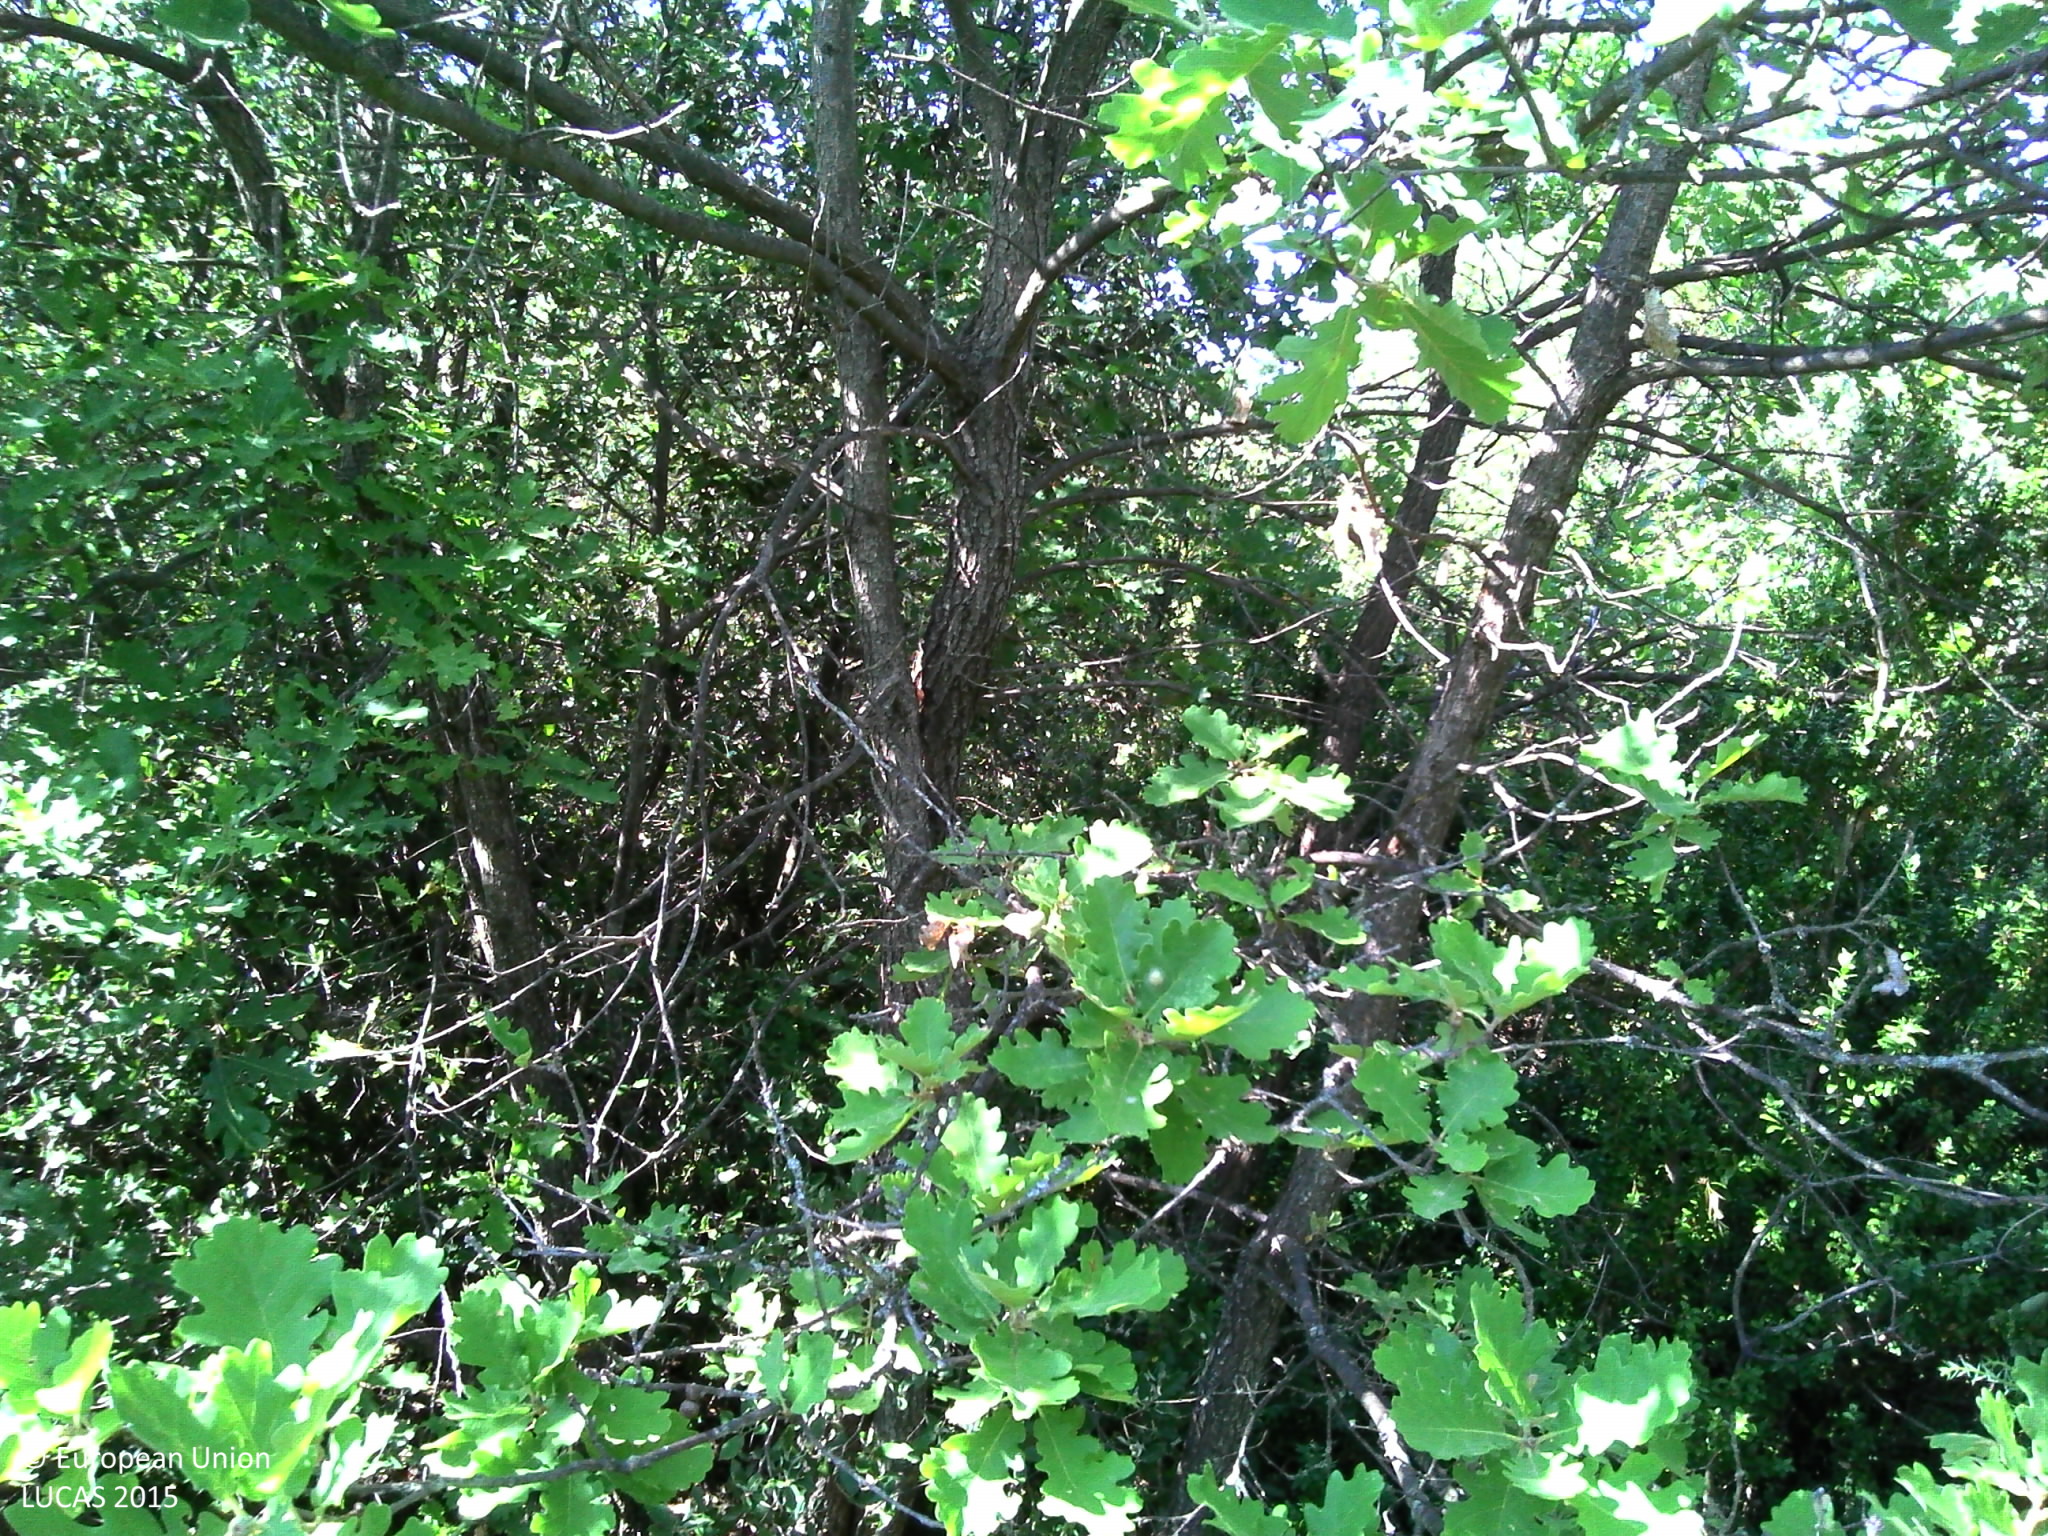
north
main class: Woodland
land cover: Broadleaved woodland
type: broadleaved evergreen forest
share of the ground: > 75 %
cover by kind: broadleaved forest trees 70 %, shrubs 15 %, coniferous forest trees 5 %, herbaceous plants 5 %, unconsolidated bare surface 5 %
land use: Forestry
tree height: < 5 m
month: July
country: FR
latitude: 43.9498
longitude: 5.1864
